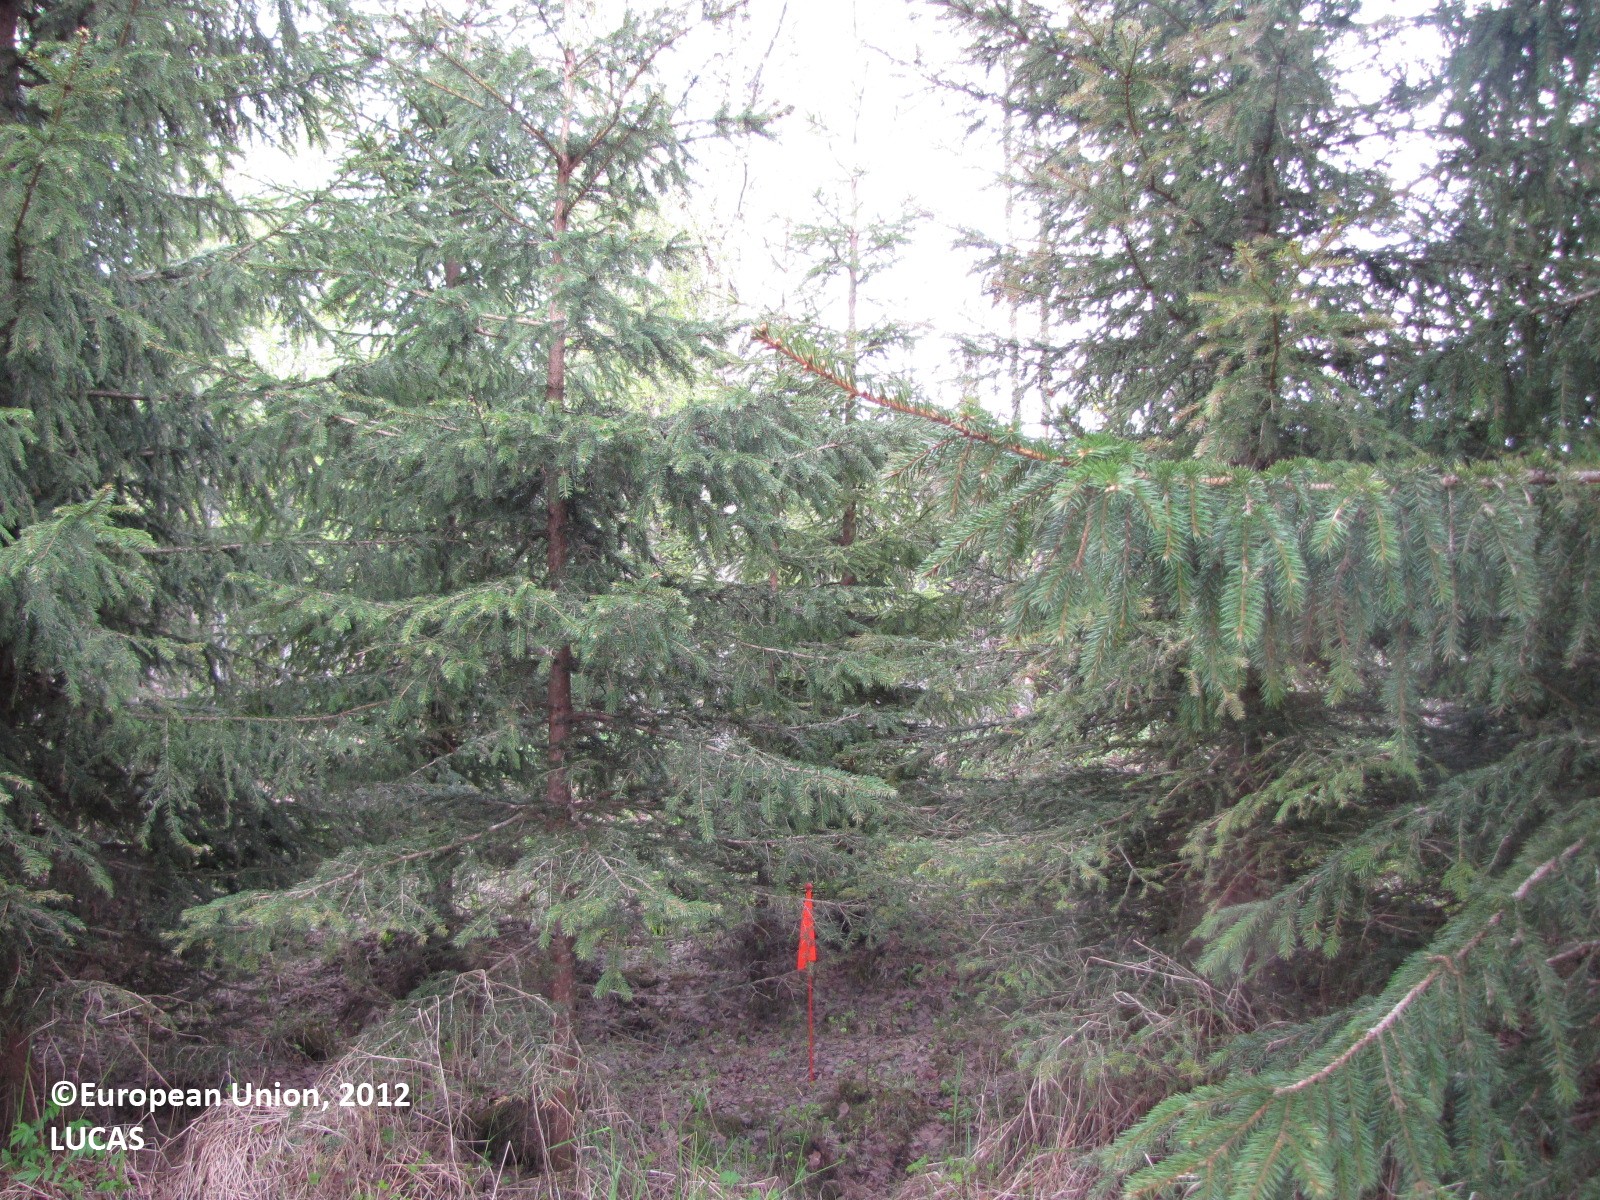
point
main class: Woodland
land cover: Spruce dominated coniferous woodland
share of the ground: > 75 %
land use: Forestry
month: June
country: FI
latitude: 65.8361
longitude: 24.4357
